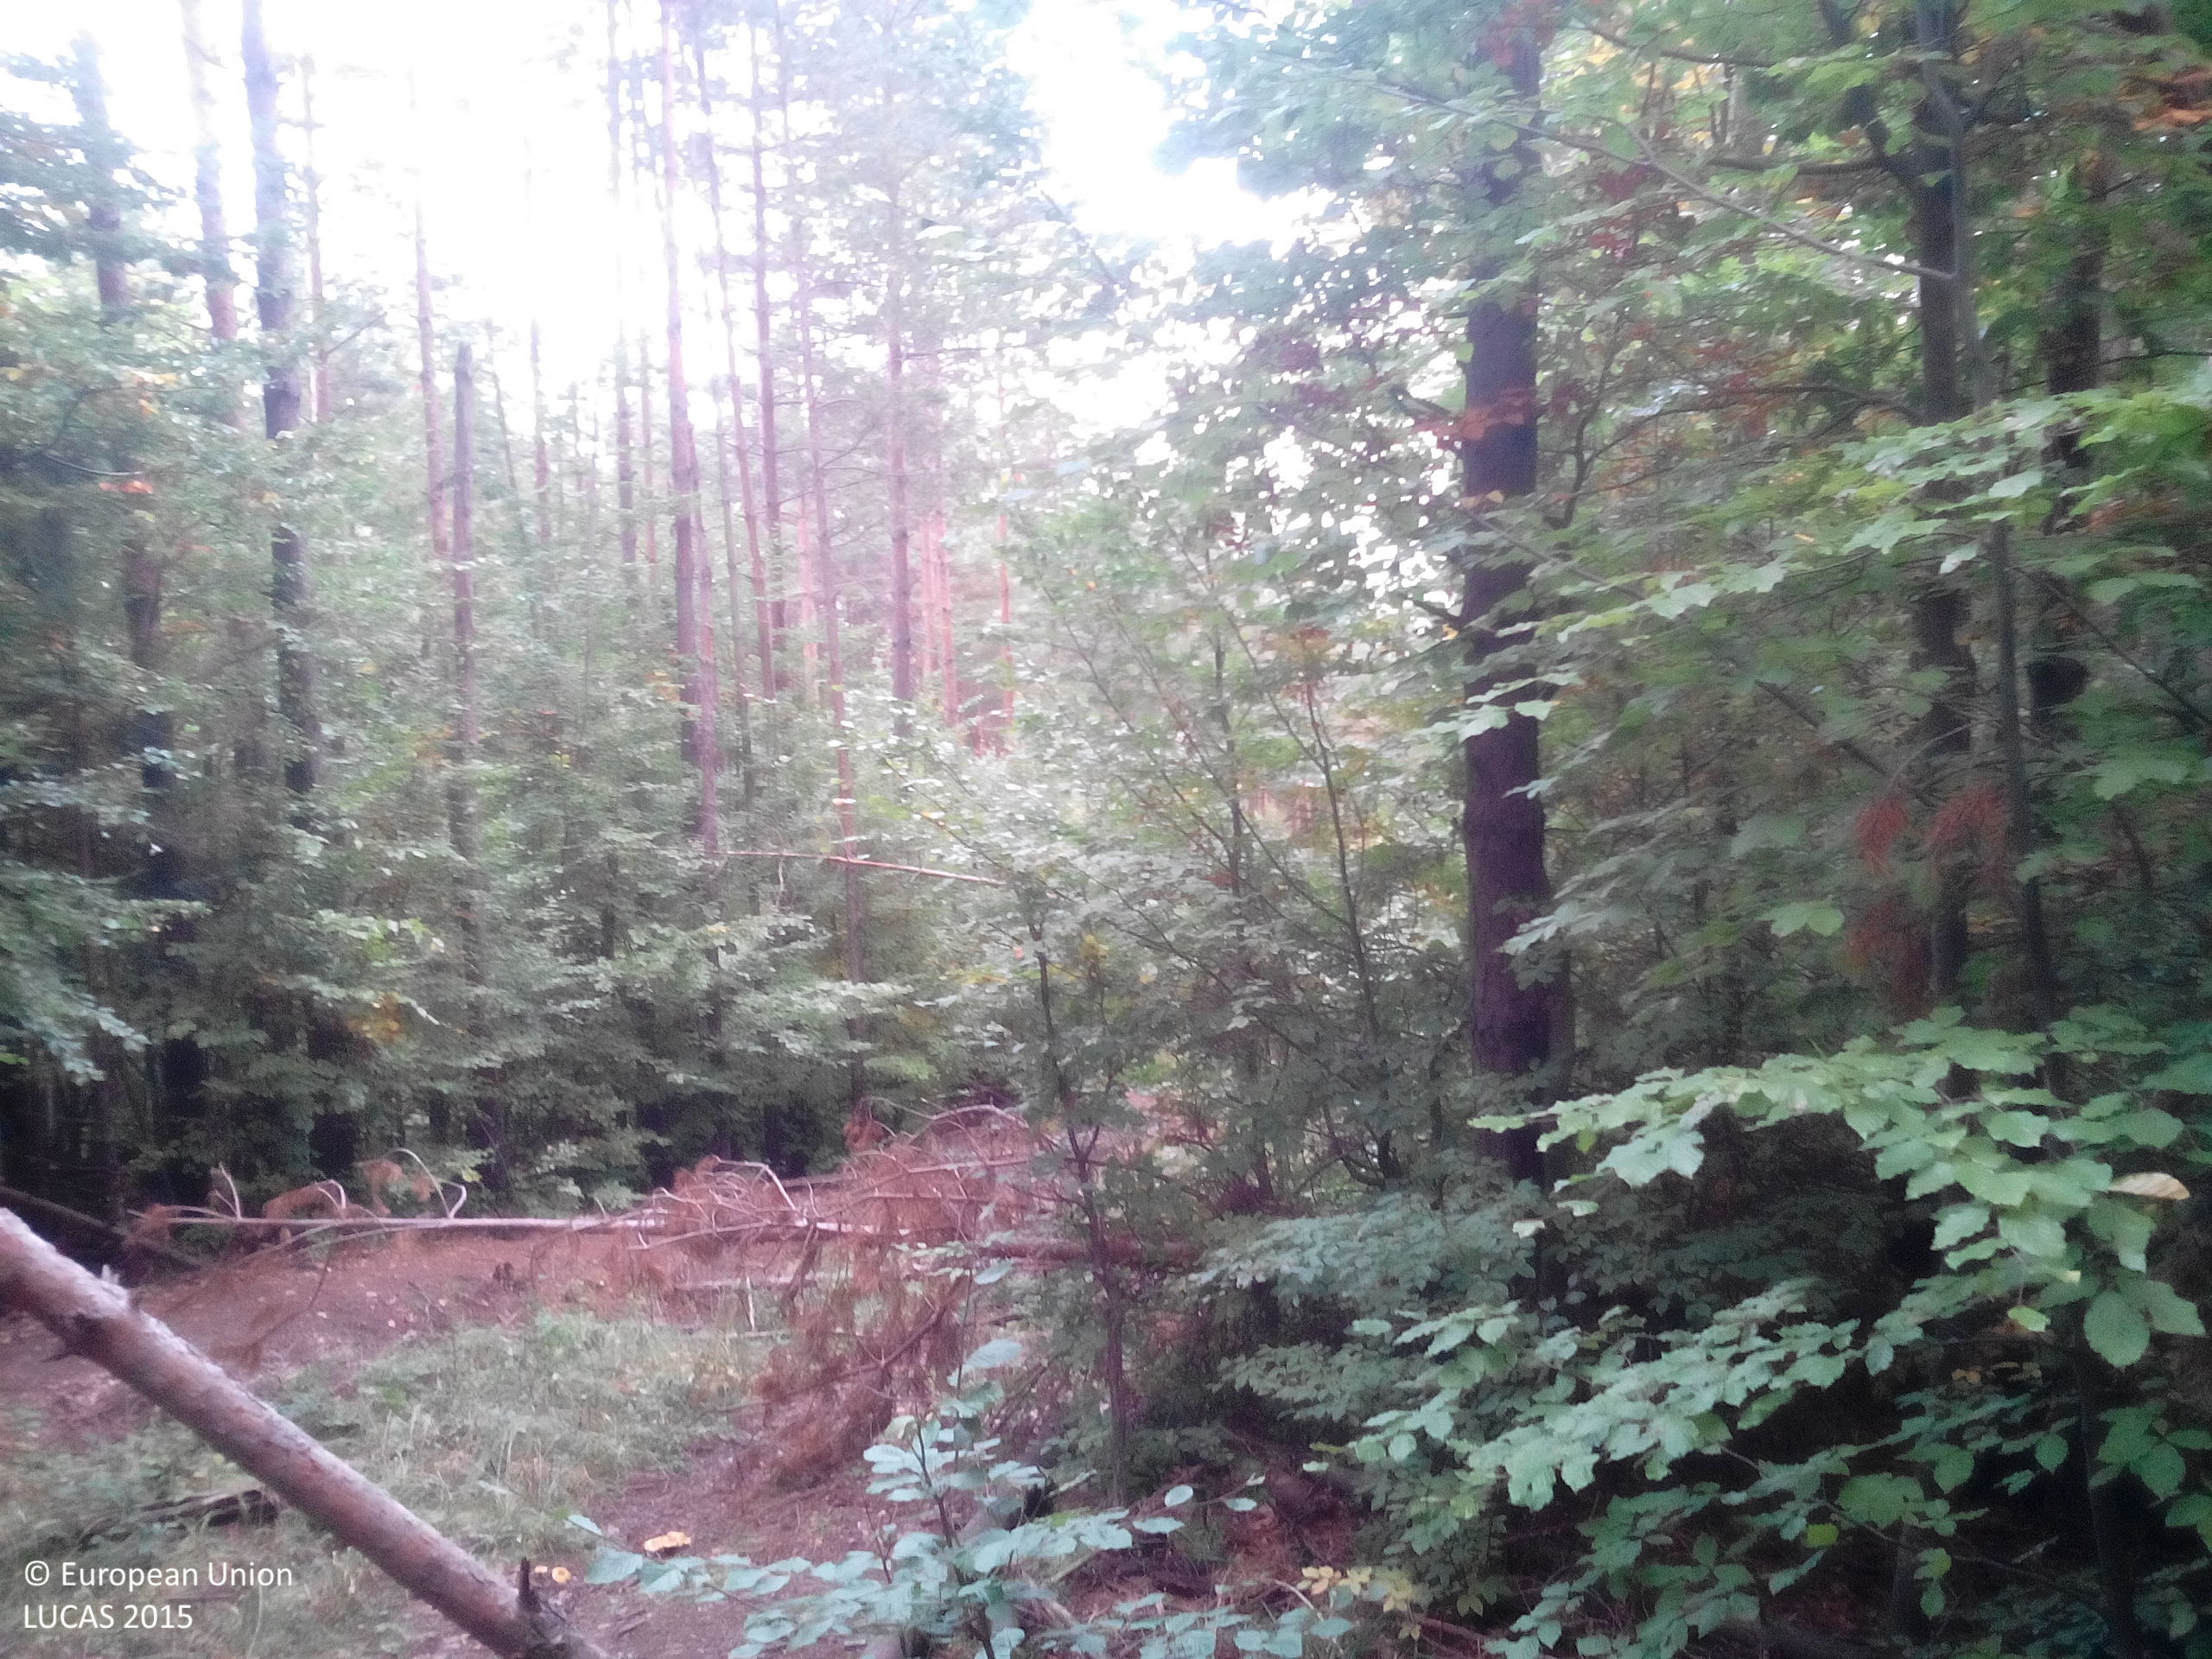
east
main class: Woodland
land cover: Pine dominated mixed woodland
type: alpine coniferous forest
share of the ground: 50 - 75 %
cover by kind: coniferous forest trees 70 %, broadleaved forest trees 25 %, shrubs 5 %
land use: Forestry
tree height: > 5 m
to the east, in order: Pine dominated mixed woodland; Tracks; Broadleaved woodland; Tracks; Broadleaved woodland
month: October
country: BG
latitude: 42.8444
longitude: 24.2813
